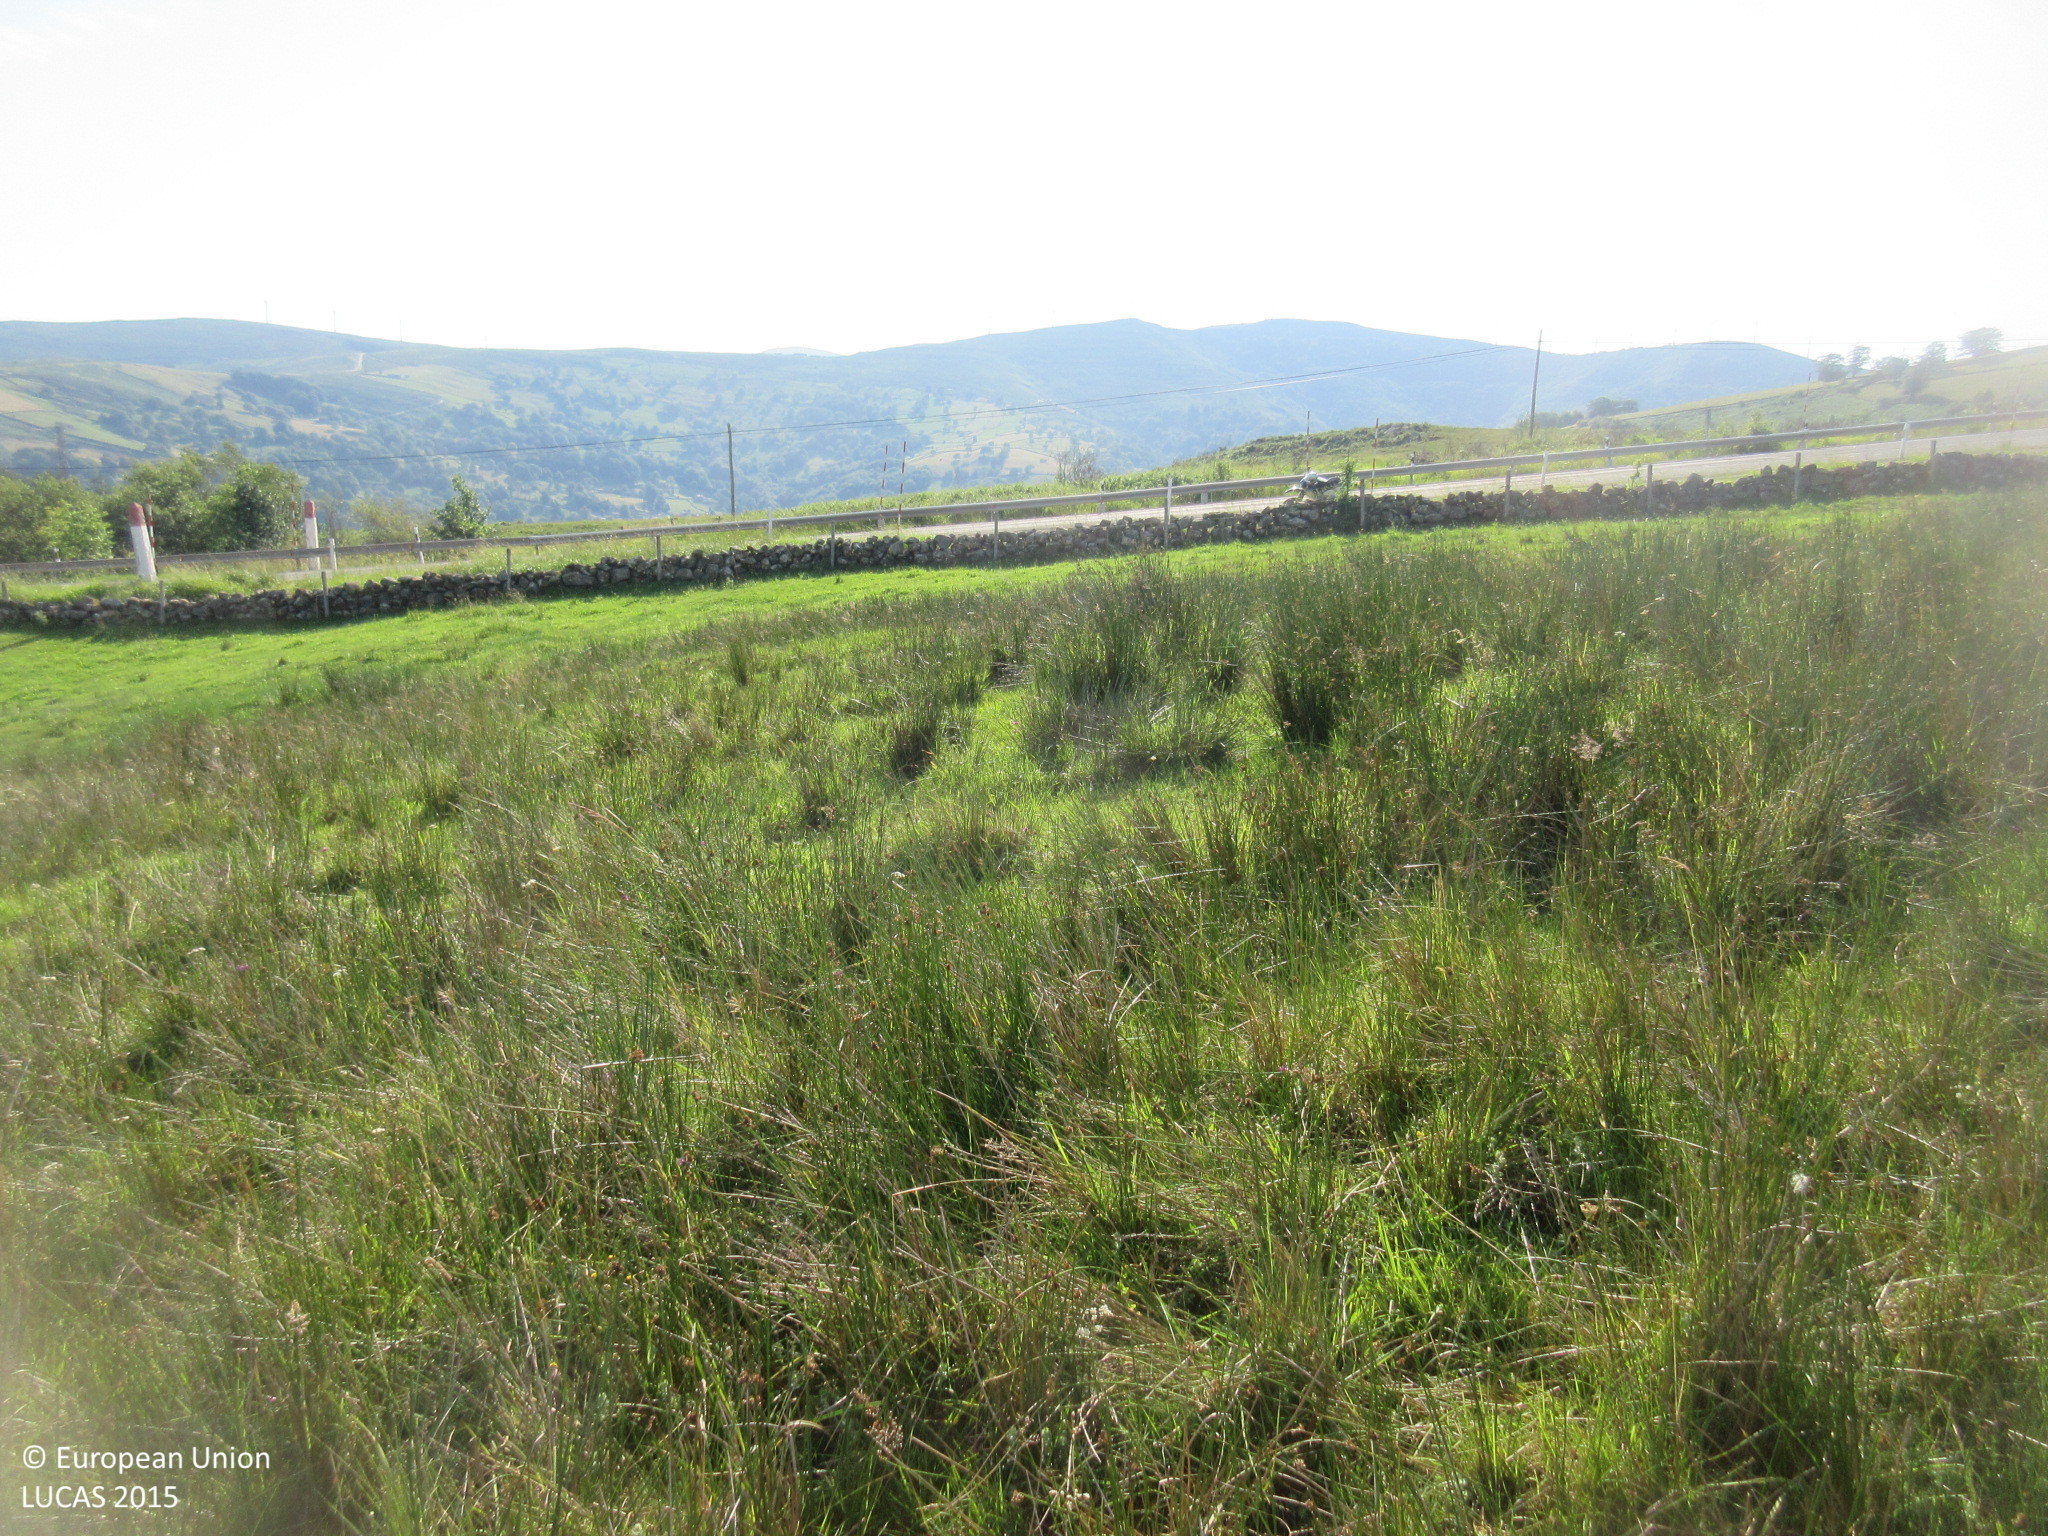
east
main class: Grassland
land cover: Grassland without tree/shrub cover
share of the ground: > 75 %
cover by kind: herbaceous plants 100 %
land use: Agriculture (excluding fallow land and kitchen gardens)
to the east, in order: Grassland without tree/shrub cover; Fences; Dry stone walls; Grass margins; Paved roads, cycling and walking lanes; Shrubland without tree cover; Fences; Electric lines; Shrubland without tree cover; Grassland without tree/shrub cover
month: July
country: ES
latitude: 43.0643
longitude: -3.8856
